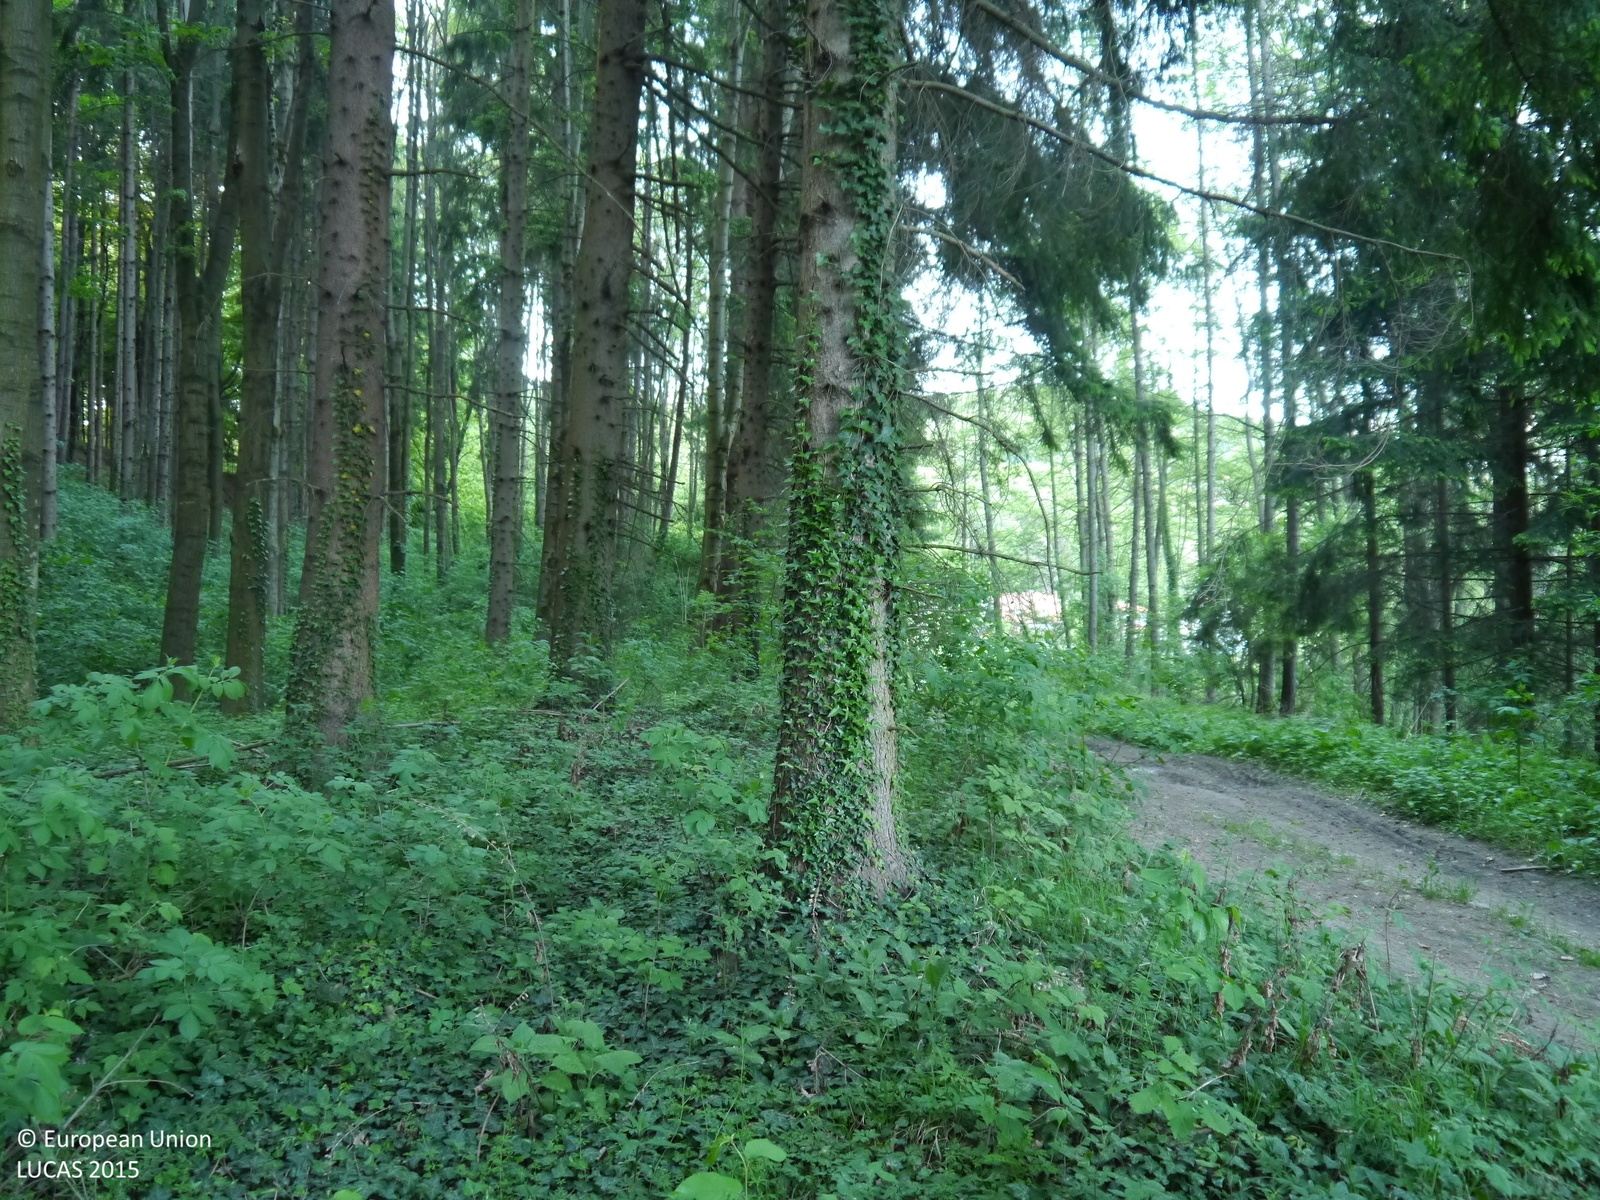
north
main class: Woodland
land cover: Spruce dominated coniferous woodland
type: hemiboreal forest and nemoral coniferous forest and mixed broadleaved-coniferous forest
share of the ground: > 75 %
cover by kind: coniferous forest trees 75 %, broadleaved forest trees 20 %, herbaceous plants 5 %
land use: Forestry
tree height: > 5 m
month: May
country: AT
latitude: 47.0843
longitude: 15.3343
